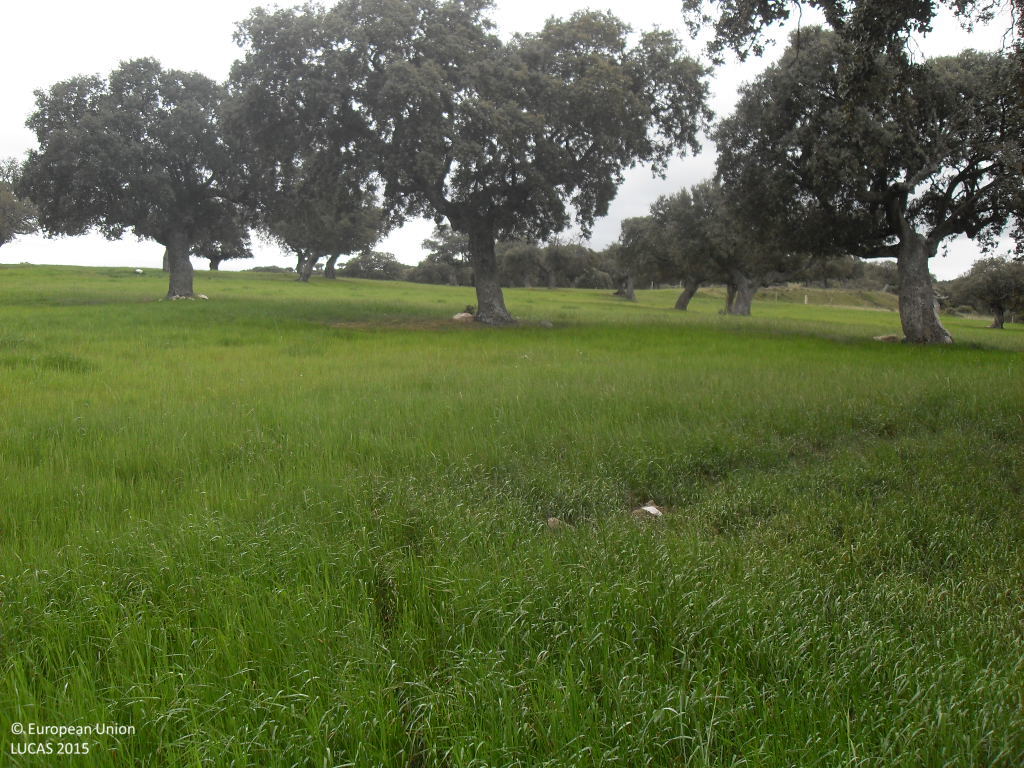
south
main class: Woodland
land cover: Broadleaved woodland
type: broadleaved evergreen forest
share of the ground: 10 - 25 %
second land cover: Temporary grasslands
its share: > 75 %
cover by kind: herbaceous plants 80 %, broadleaved forest trees 20 %
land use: Forestry
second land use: Agriculture (excluding fallow land and kitchen gardens)
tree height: > 5 m
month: April
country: ES
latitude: 40.6912
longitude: -5.3201
